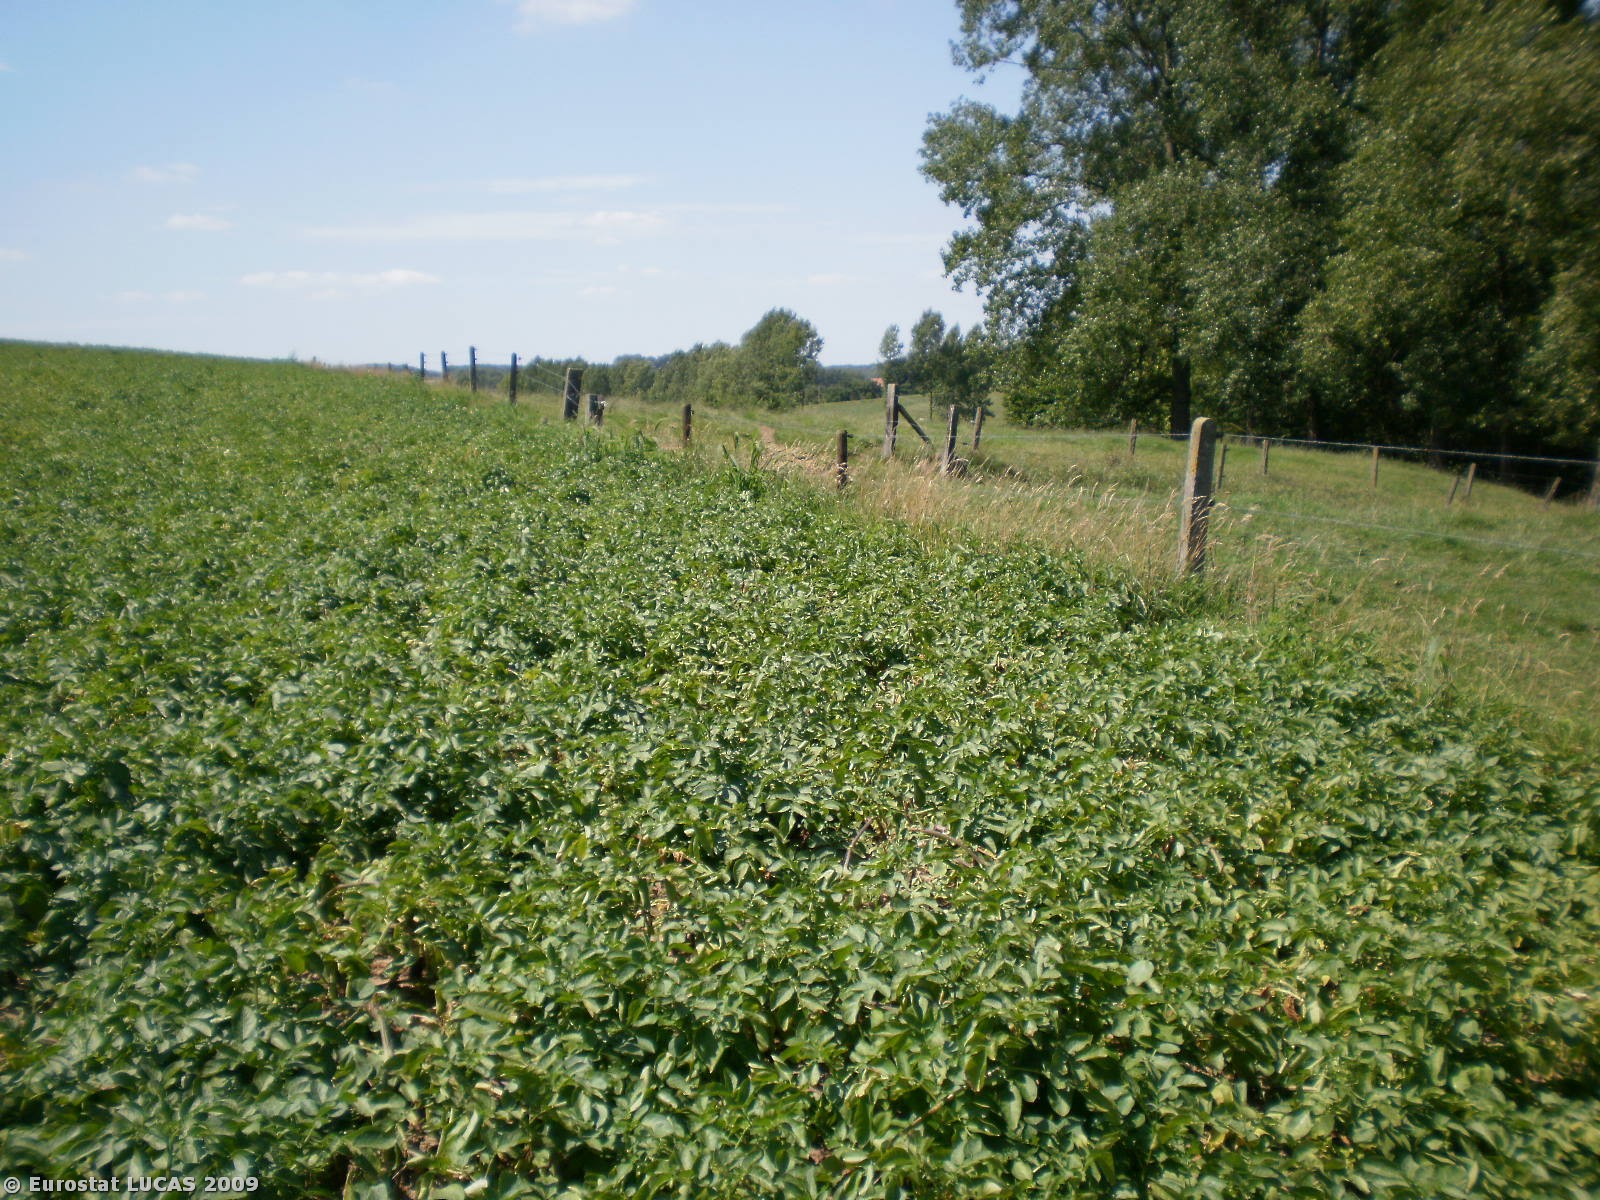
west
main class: Grassland
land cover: Grassland without tree/shrub cover
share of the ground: > 75 %
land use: Agriculture (excluding fallow land and kitchen gardens)
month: August
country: BE
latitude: 50.8265
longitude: 3.7894
